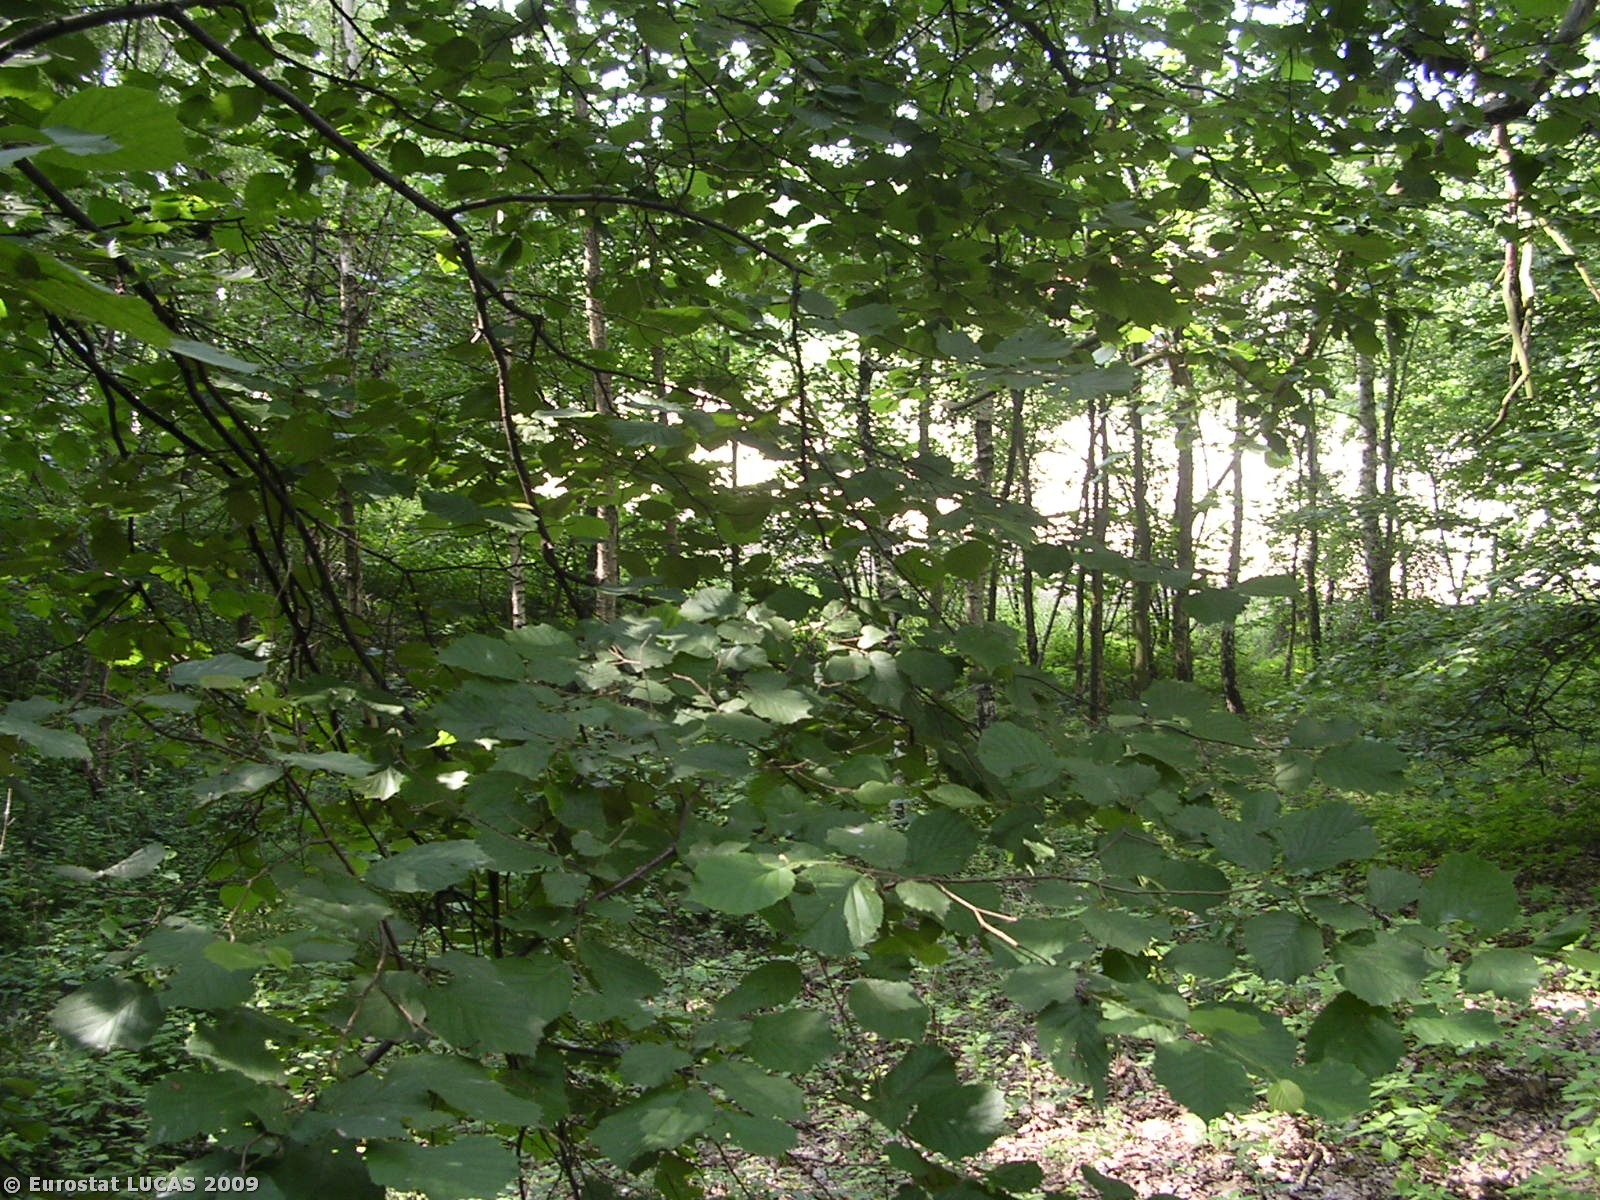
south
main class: Woodland
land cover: Broadleaved woodland
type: non-riverine alder, birch or aspen forest
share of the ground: > 75 %
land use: Forestry
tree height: > 5 m
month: June
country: CZ
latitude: 50.5911
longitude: 14.2532
